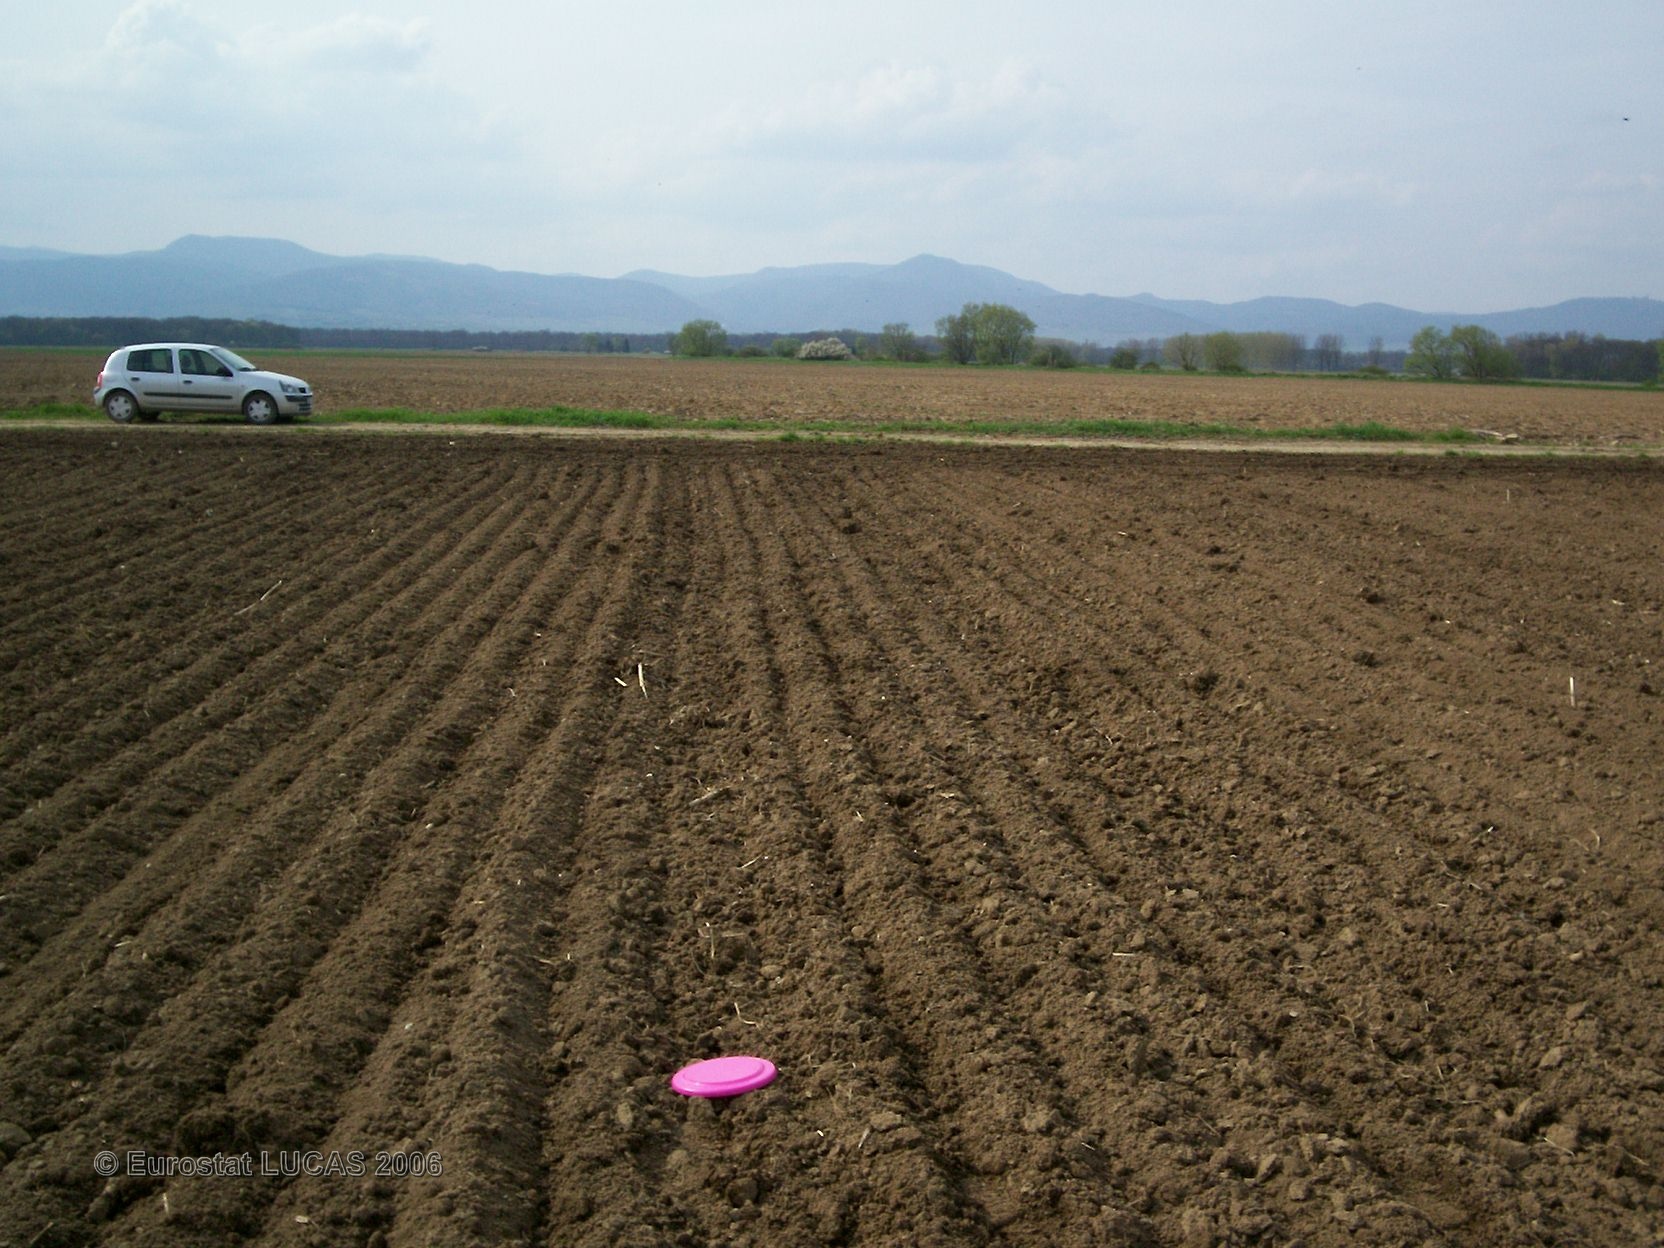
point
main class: Cropland
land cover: Maize
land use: Agriculture (excluding fallow land and kitchen gardens)
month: May
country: FR
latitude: 48.1391
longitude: 7.4074
